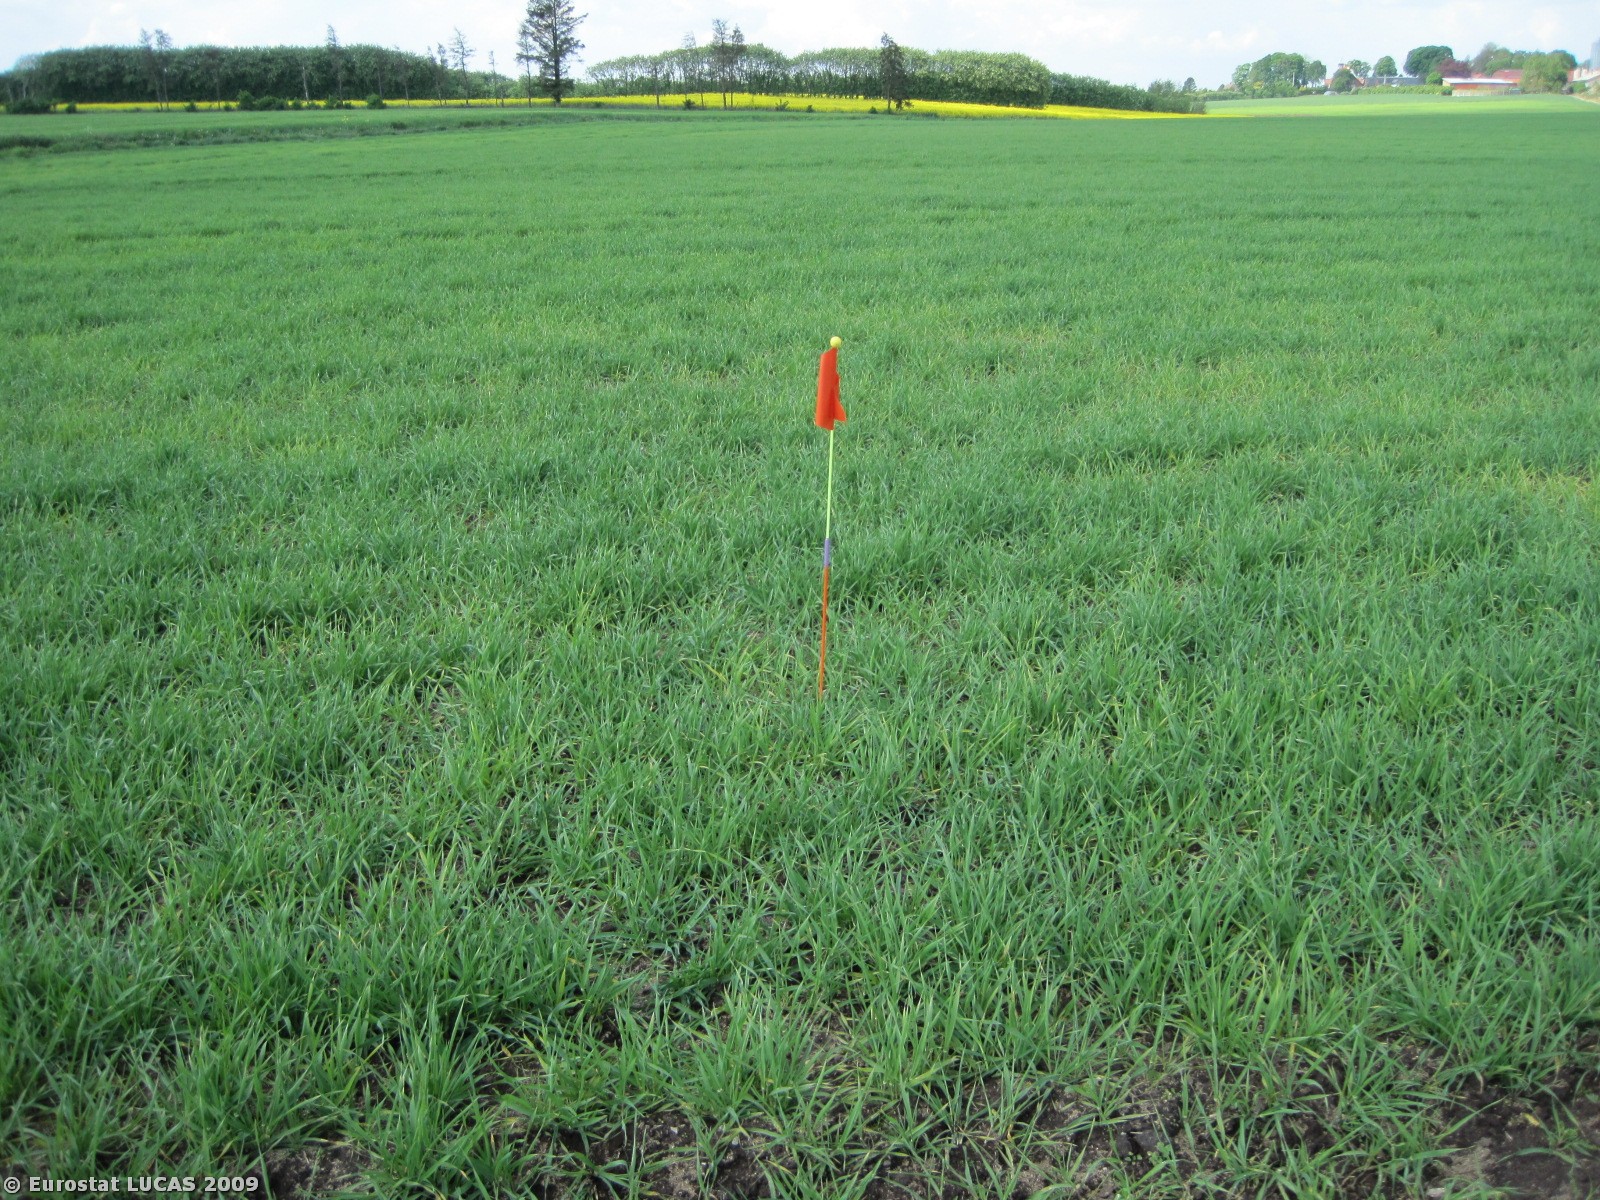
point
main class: Cropland
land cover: Barley
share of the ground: > 75 %
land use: Agriculture (excluding fallow land and kitchen gardens)
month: May
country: DK
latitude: 56.3492
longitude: 9.6929
